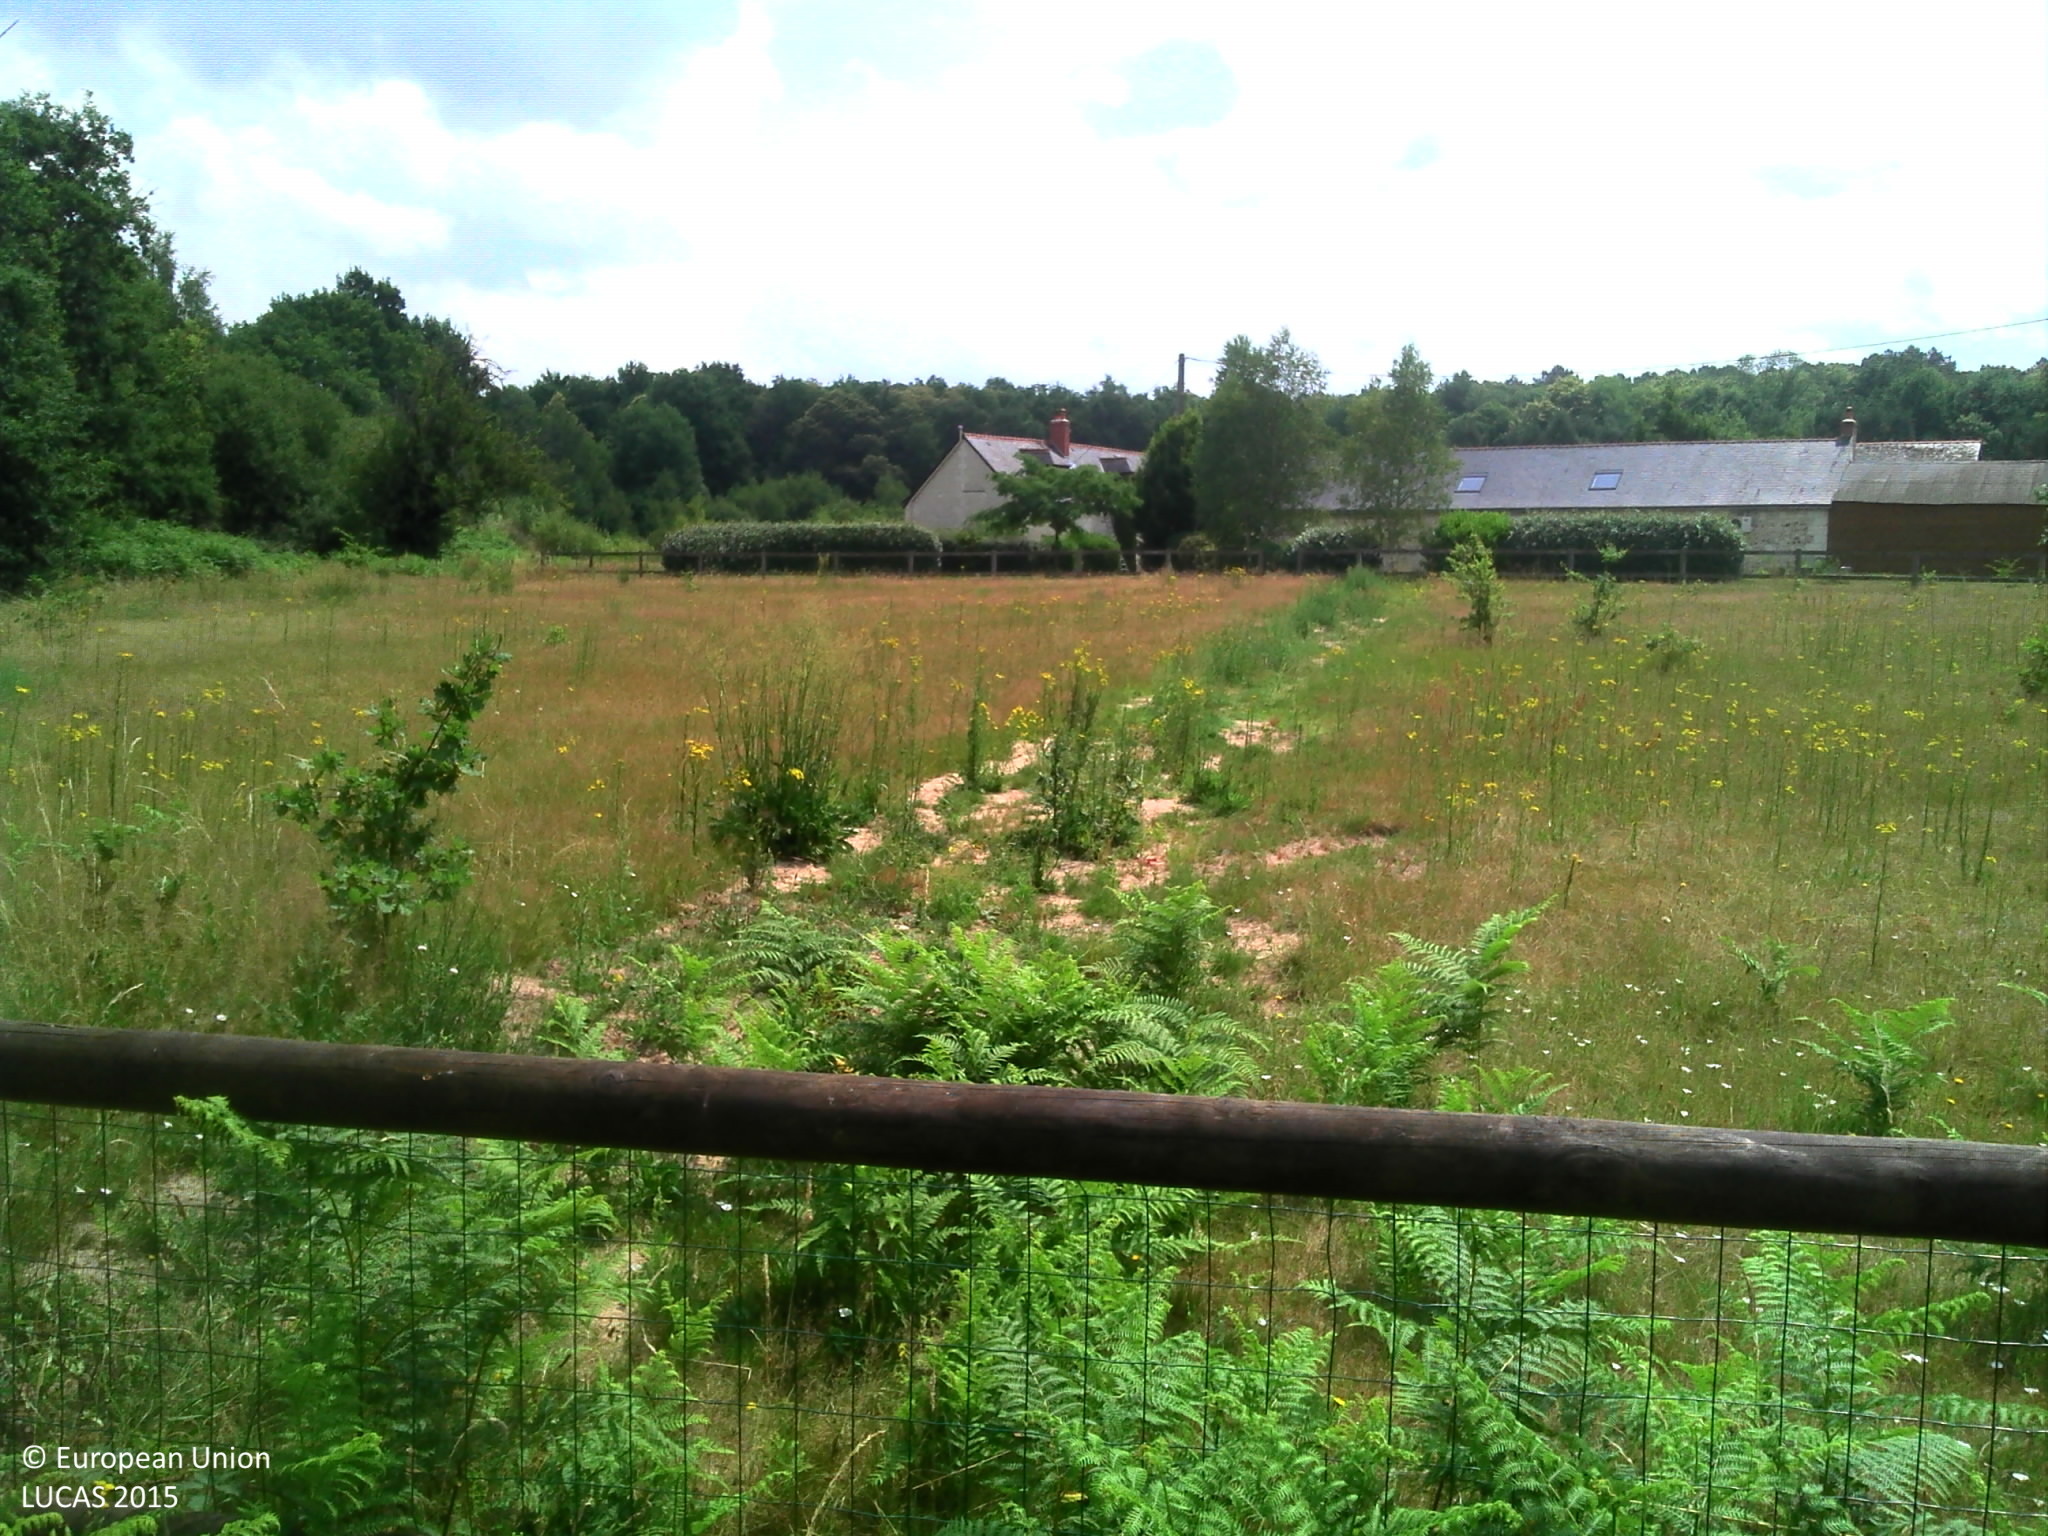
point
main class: Grassland
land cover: Grassland without tree/shrub cover
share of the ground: > 75 %
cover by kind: herbaceous plants 100 %
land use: Agriculture (excluding fallow land and kitchen gardens)
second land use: Residential
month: July
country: FR
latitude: 47.3253
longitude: 0.1184
